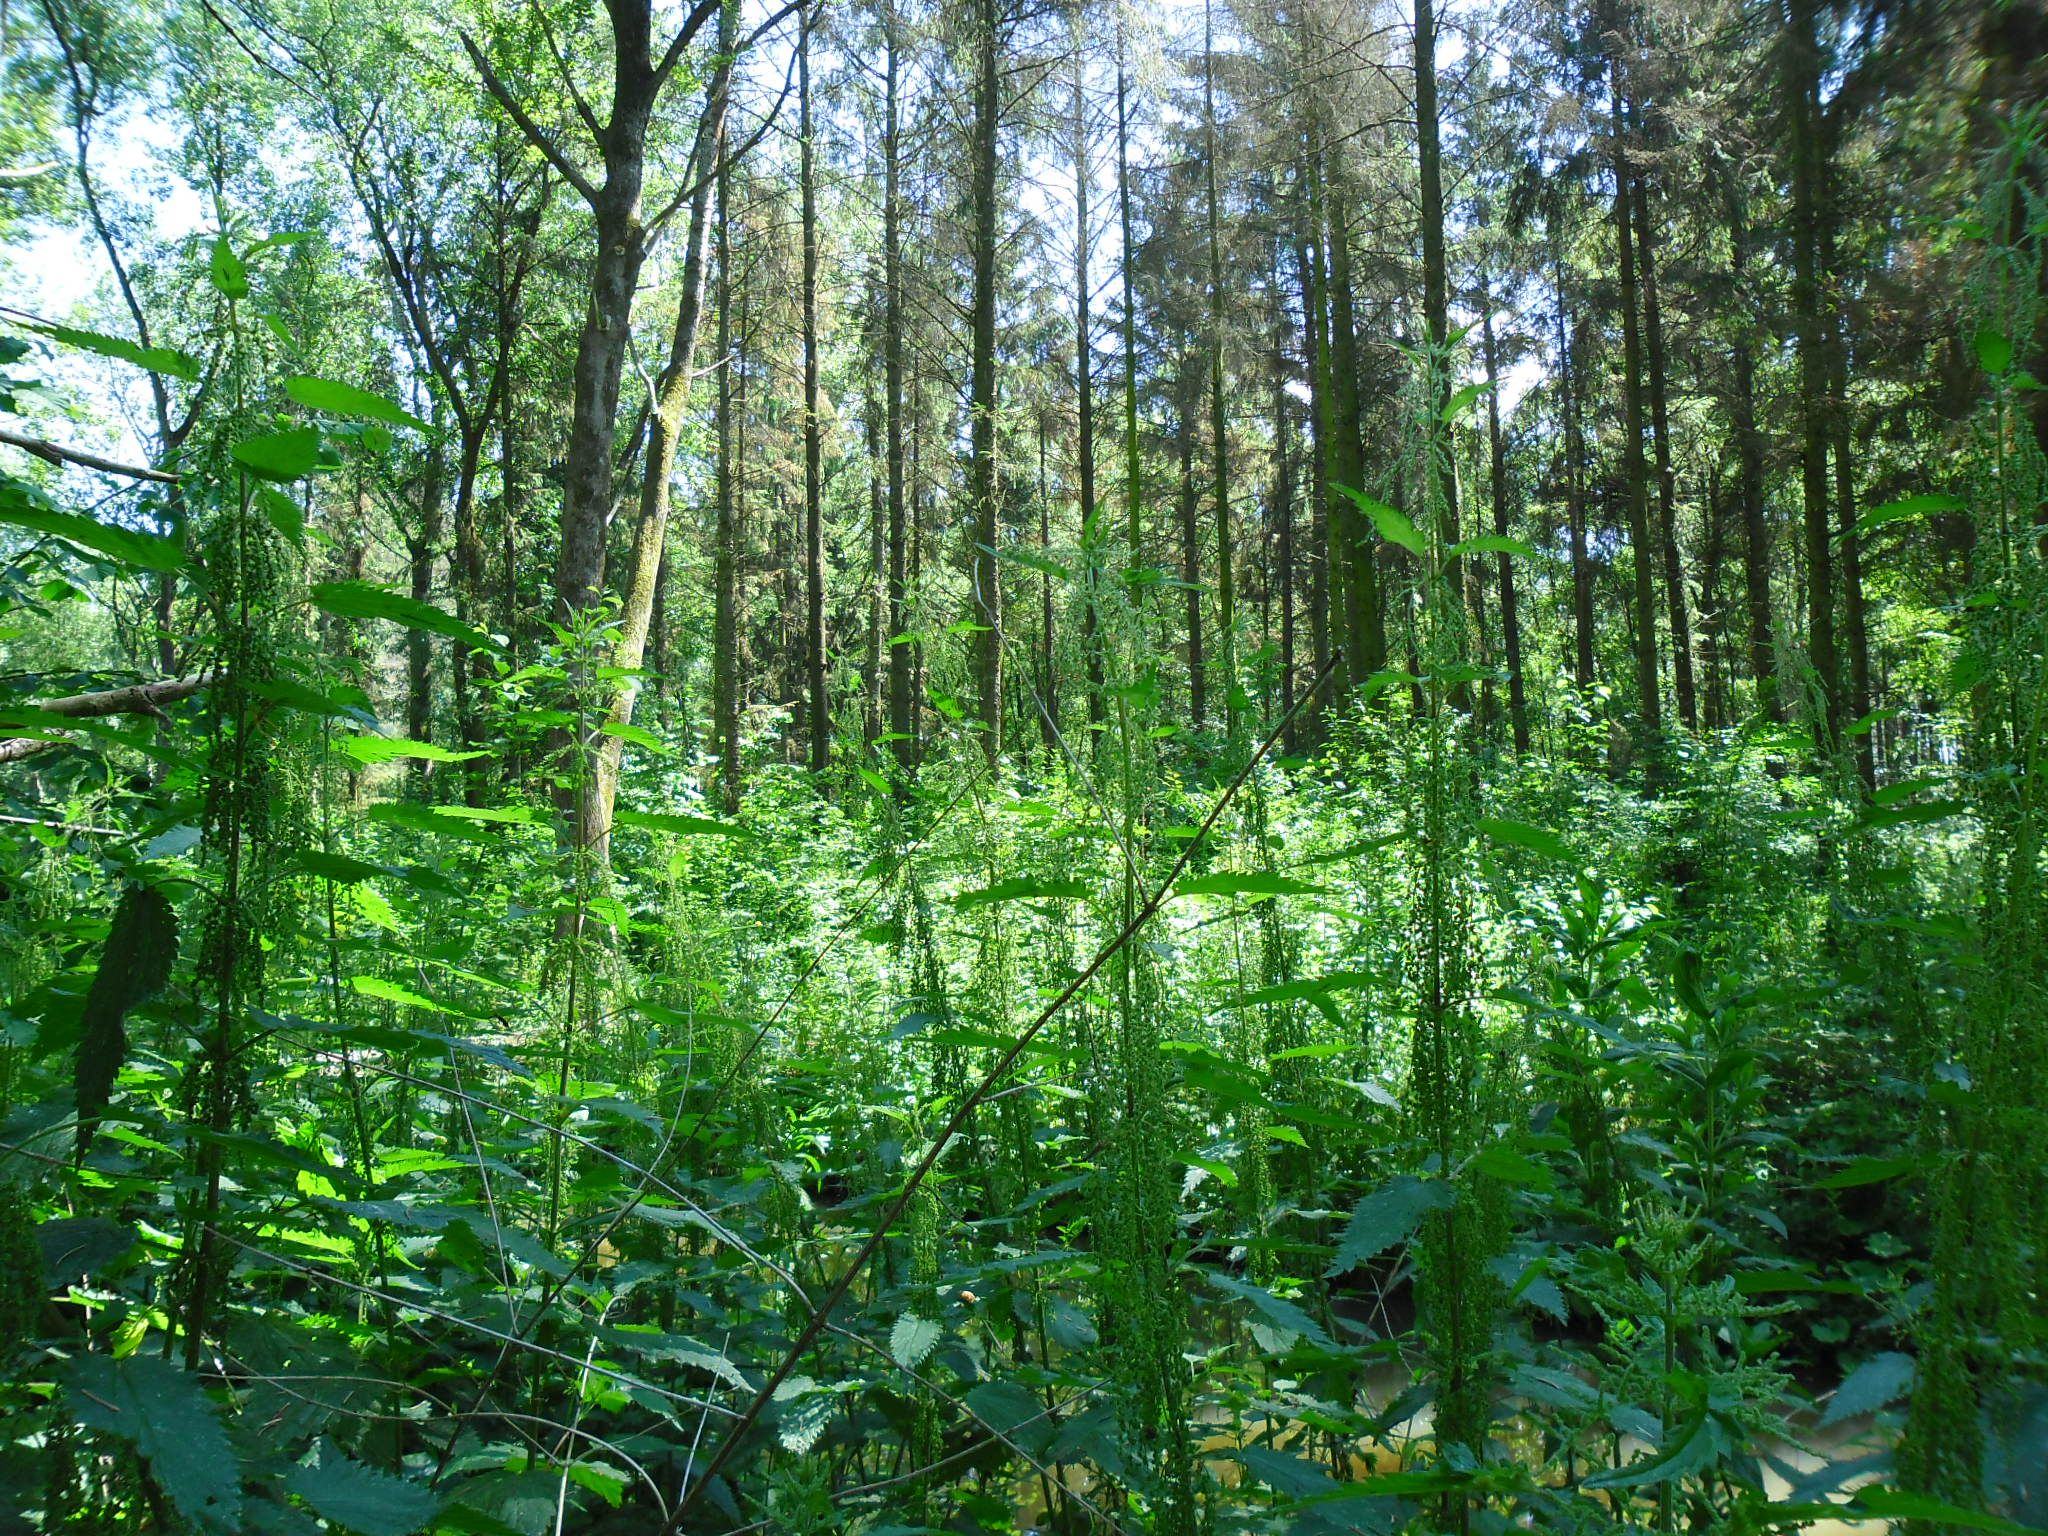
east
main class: Woodland
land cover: Broadleaved woodland
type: mesophytic deciduous forest
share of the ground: > 75 %
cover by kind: broadleaved forest trees 100 %
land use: Amenities, museums, leisure
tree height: > 5 m
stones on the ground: < 10 %
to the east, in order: Broadleaved woodland; Grassland without tree/shrub cover; Tracks; Grassland without tree/shrub cover; Artificial constructions in urban areas; Broadleaved woodland
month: June
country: NL
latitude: 52.5432
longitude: 5.4716
